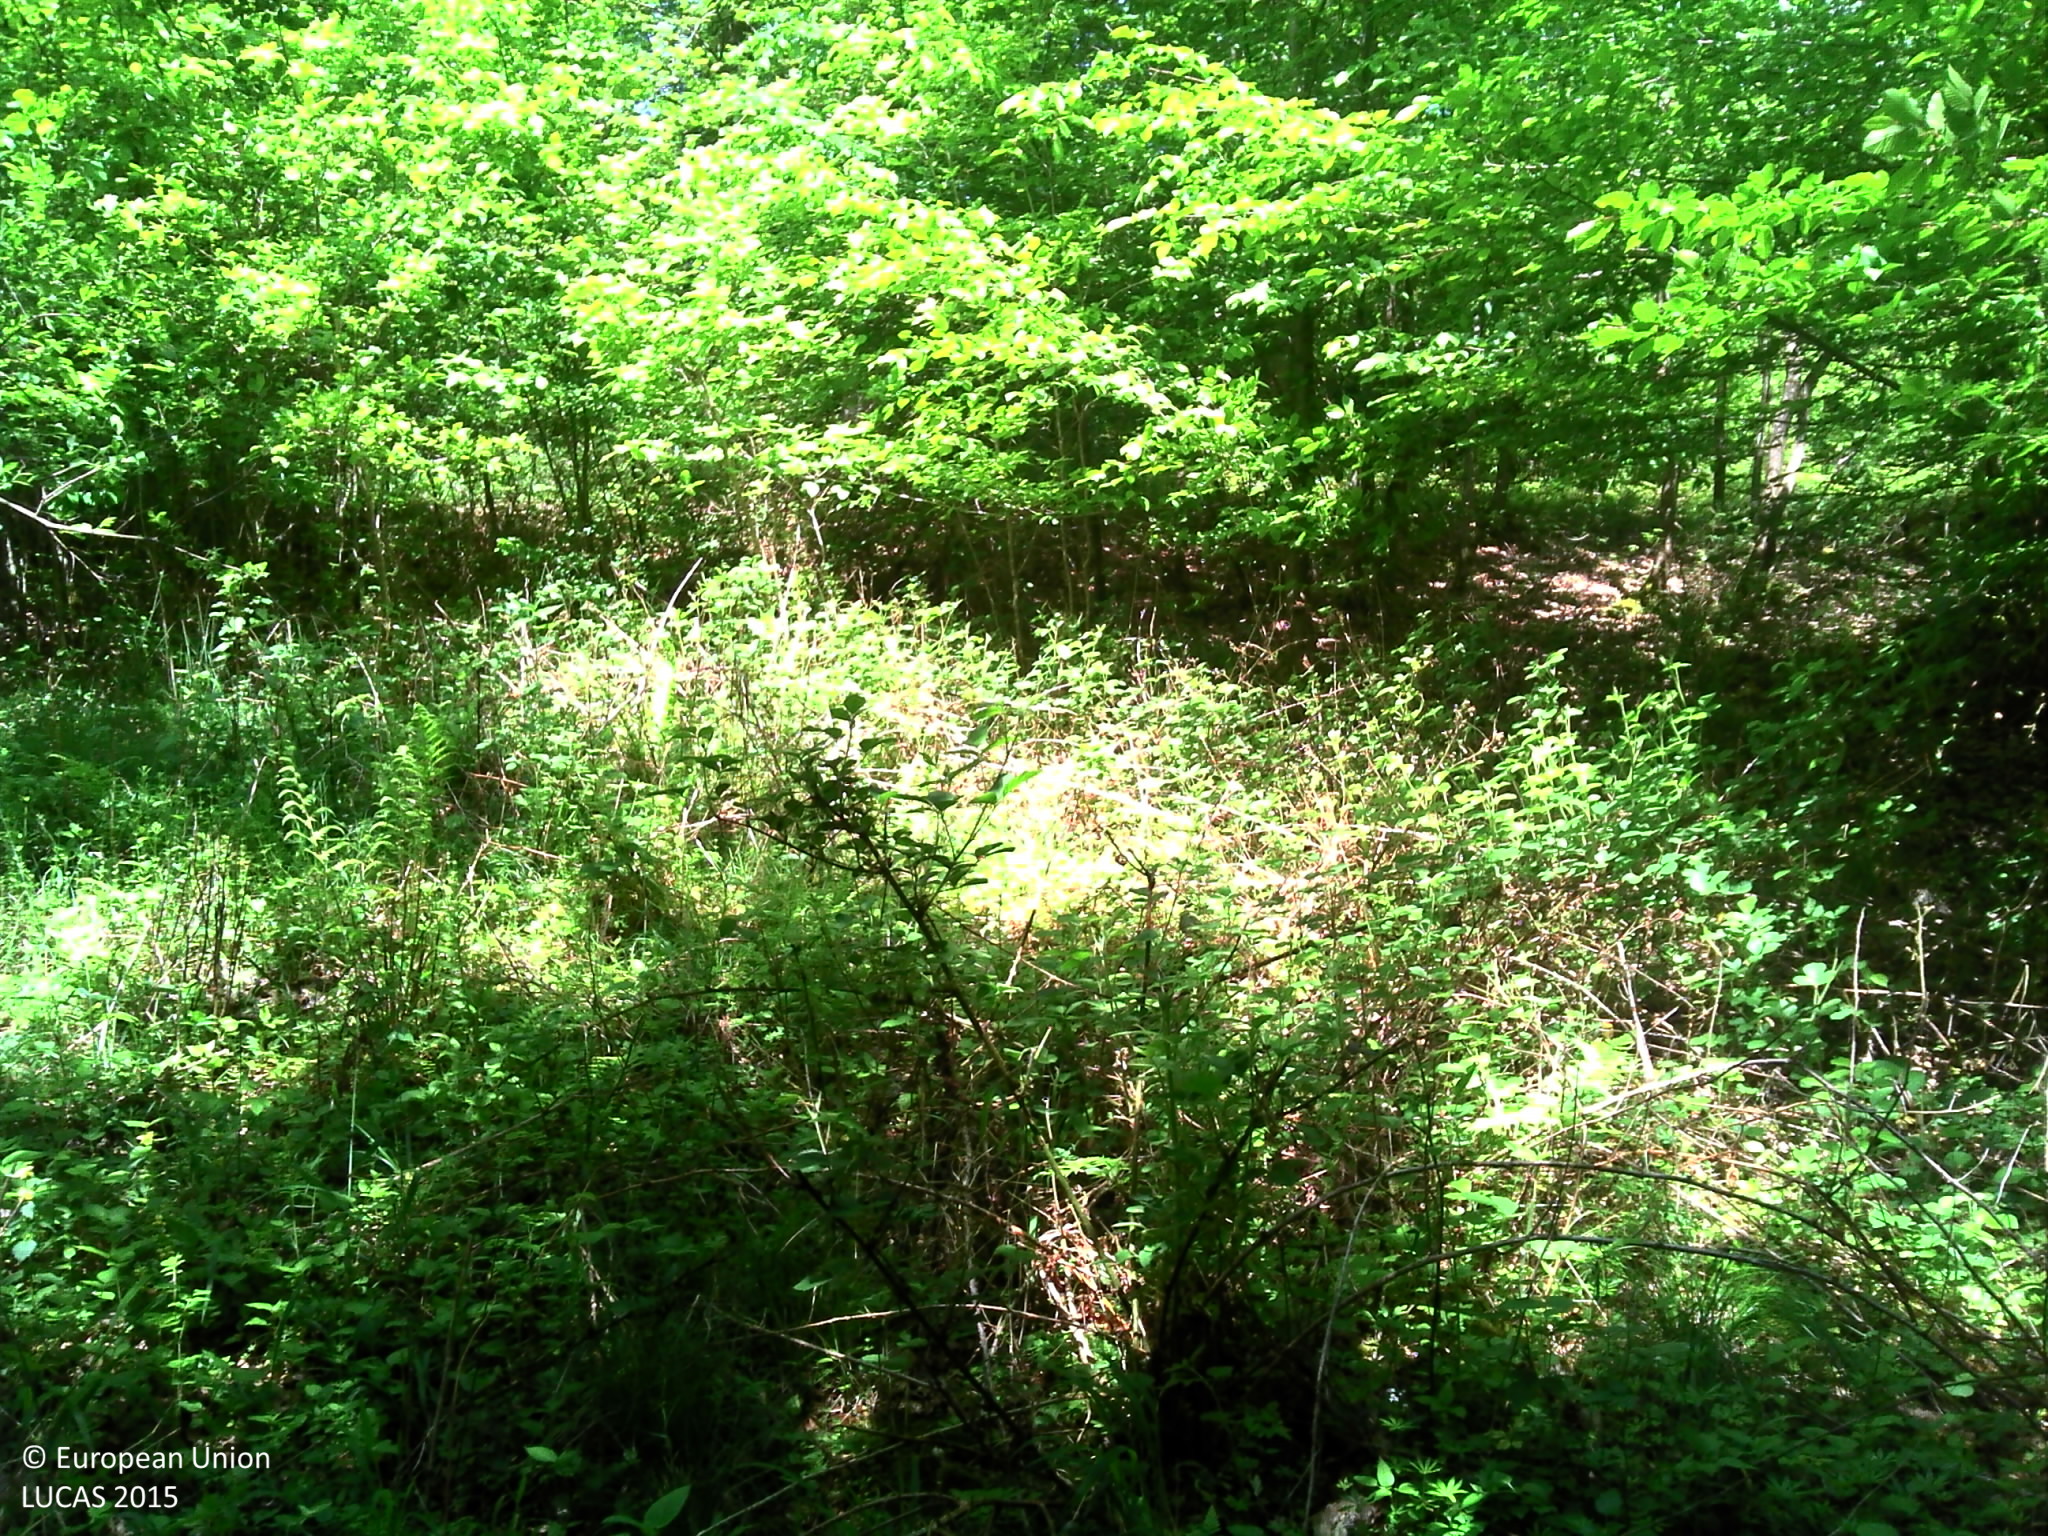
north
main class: Woodland
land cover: Broadleaved woodland
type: acidophilous oak and oak-birch forest
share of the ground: > 75 %
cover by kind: broadleaved forest trees 80 %, herbaceous plants 10 %, lichens and mosses 10 %
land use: Forestry
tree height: > 5 m
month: May
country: LU
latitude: 49.6912
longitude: 6.2706
